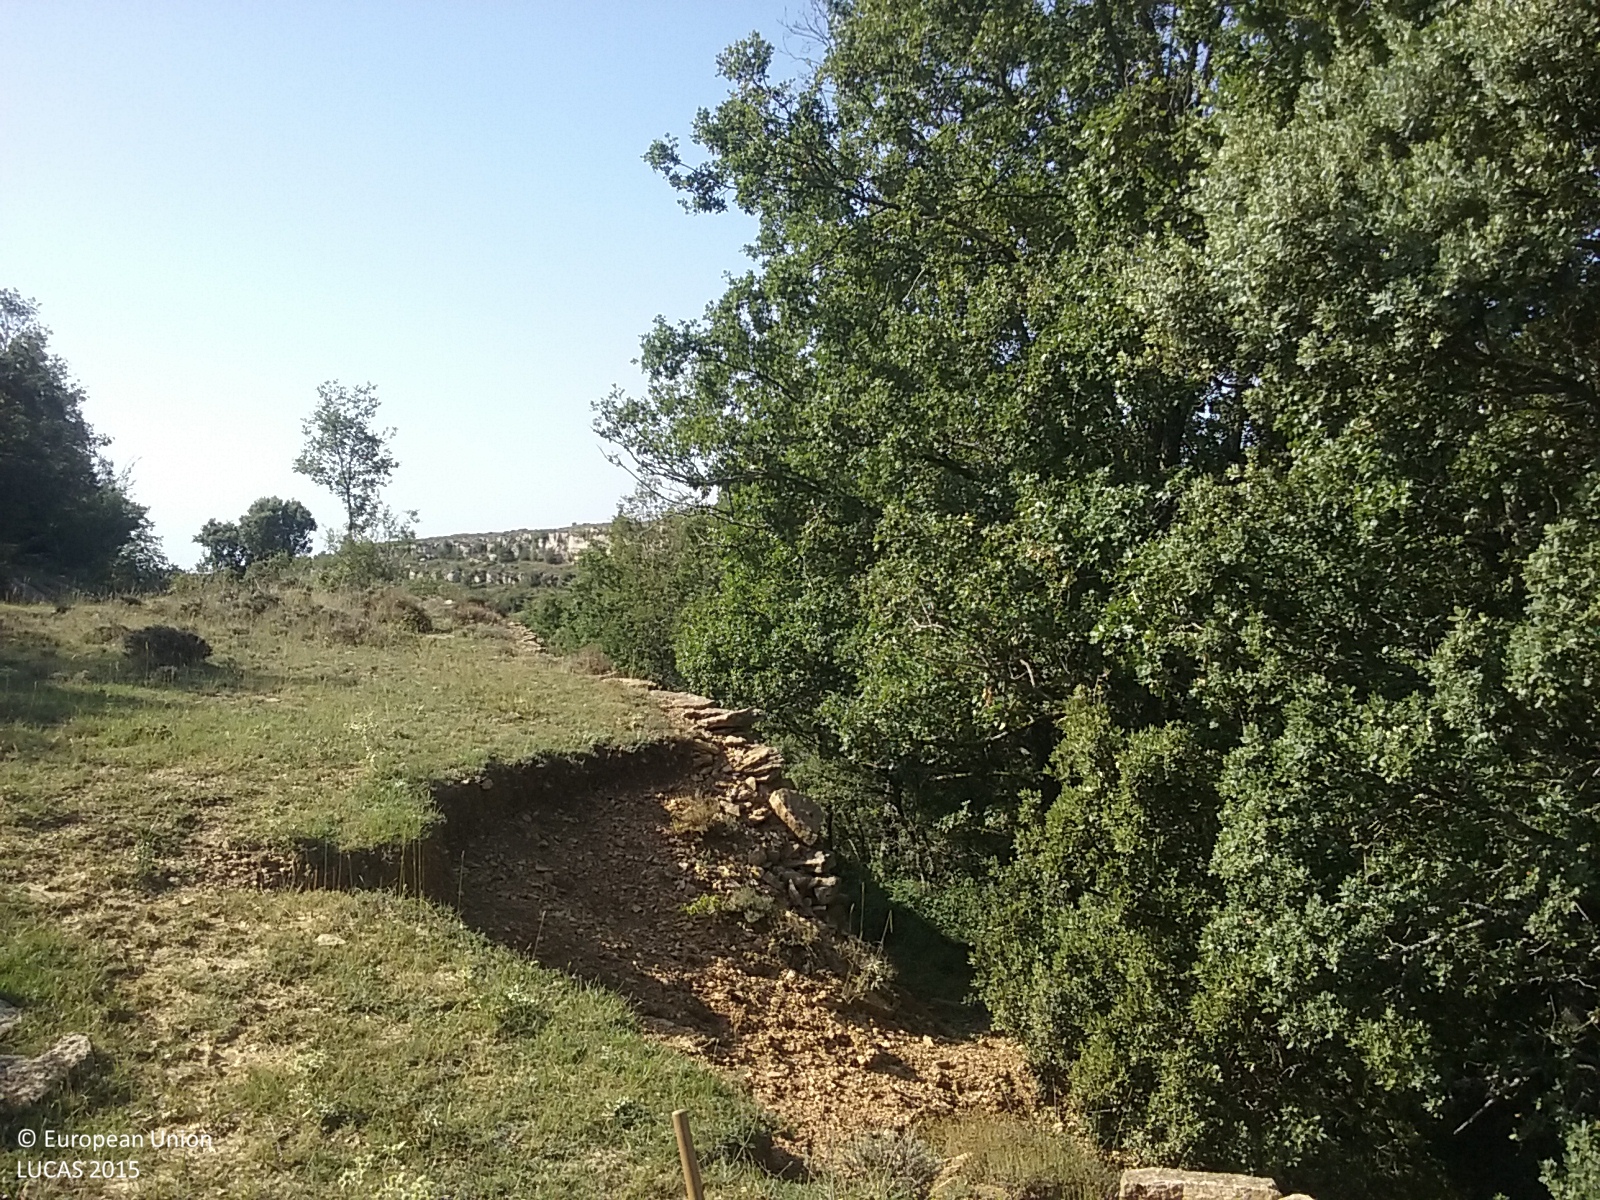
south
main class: Grassland
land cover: Grassland without tree/shrub cover
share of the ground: > 75 %
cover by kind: herbaceous plants 95 %, shrubs 5 %
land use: Agriculture (excluding fallow land and kitchen gardens)
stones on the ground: < 10 %
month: August
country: ES
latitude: 40.4624
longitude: -0.2075
